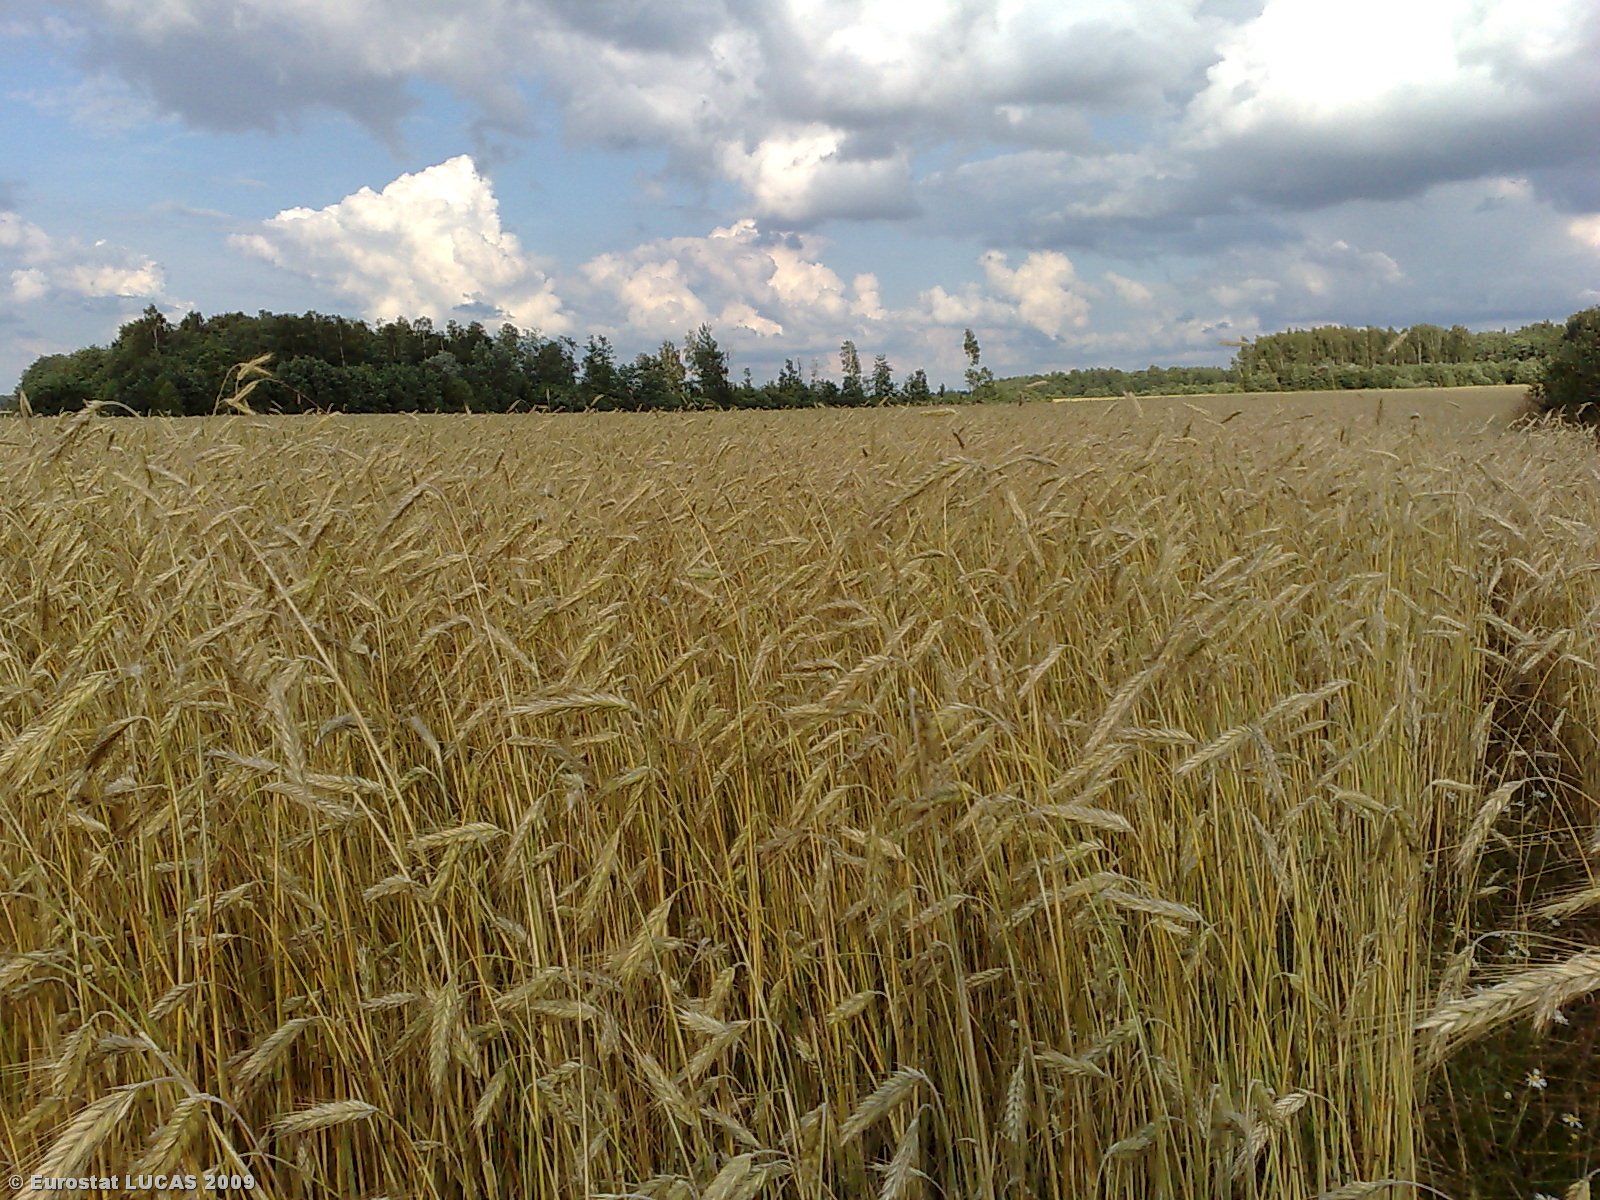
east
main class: Cropland
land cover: Rye
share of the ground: > 75 %
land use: Agriculture (excluding fallow land and kitchen gardens)
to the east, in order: Rye
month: July
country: LT
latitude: 56.1471
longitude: 22.9594
